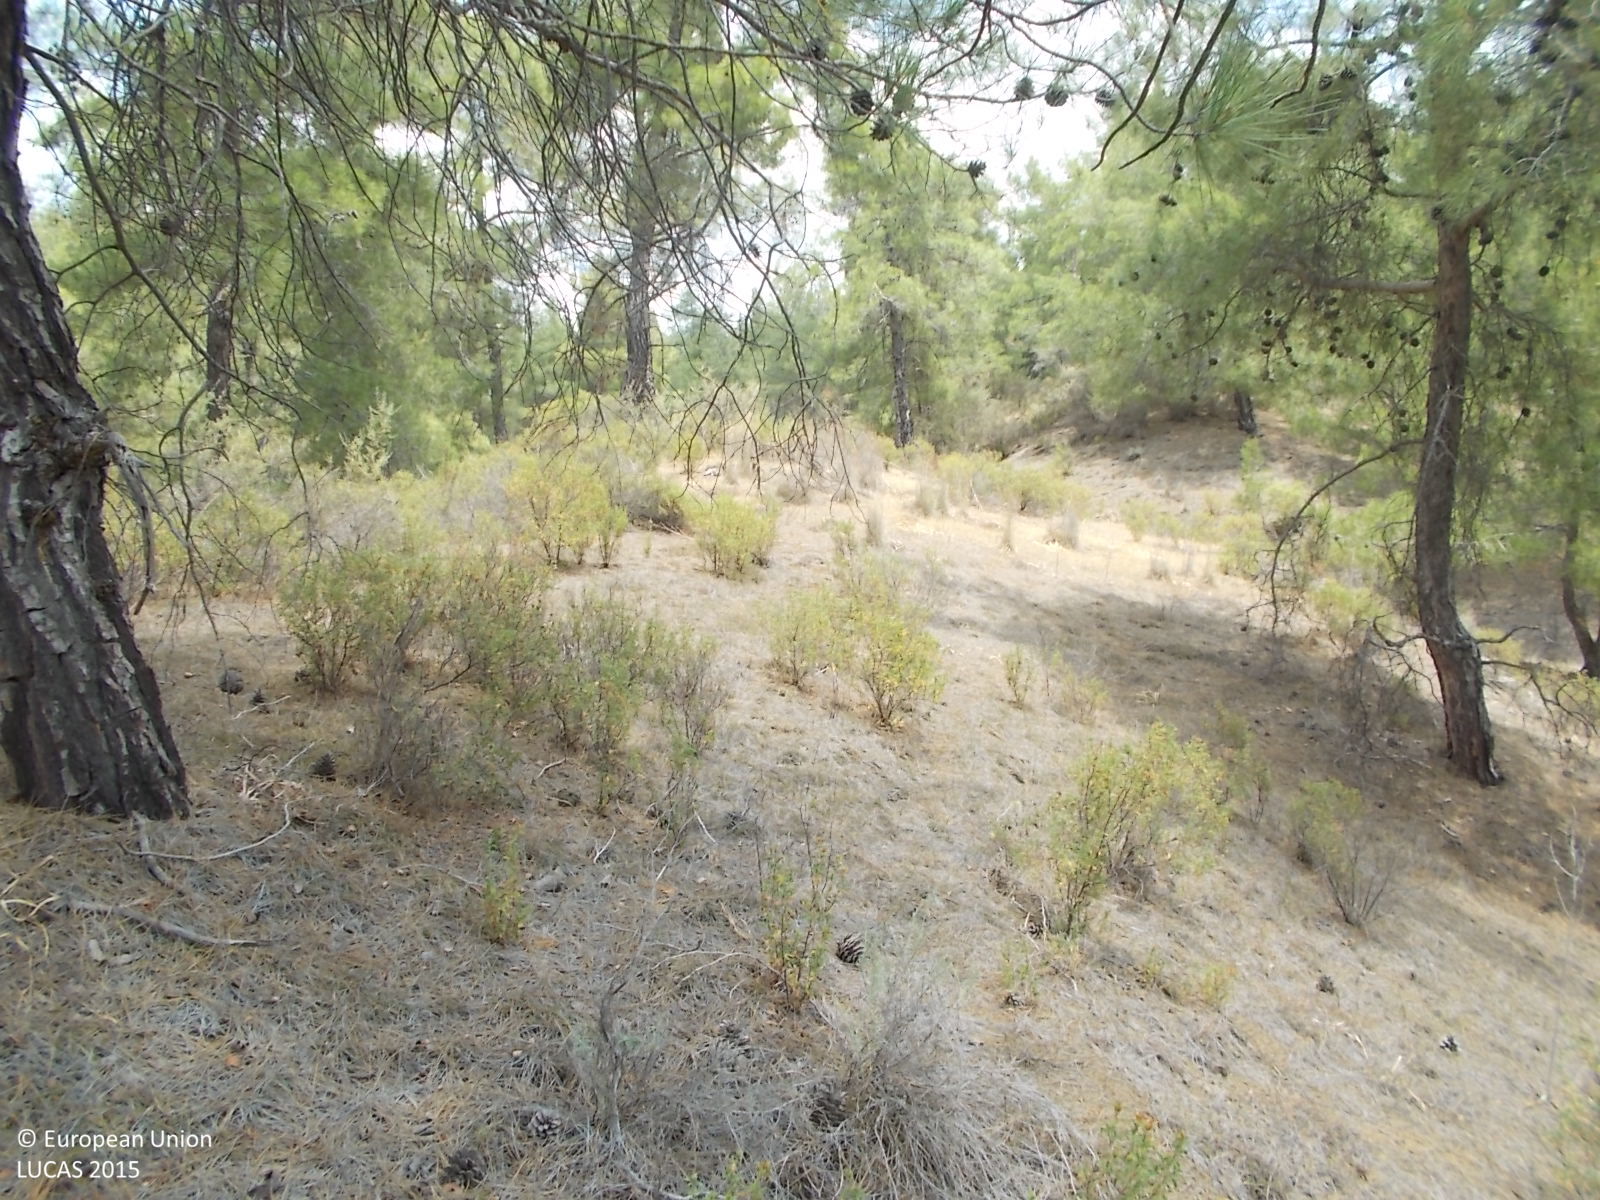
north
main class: Woodland
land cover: Pine dominated coniferous woodland
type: coniferous forest of the mediterranean region
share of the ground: 50 - 75 %
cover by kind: coniferous forest trees 70 %, unconsolidated bare surface 20 %, shrubs 10 %
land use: Forestry
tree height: > 5 m
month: June
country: CY
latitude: 34.8932
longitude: 32.7574
